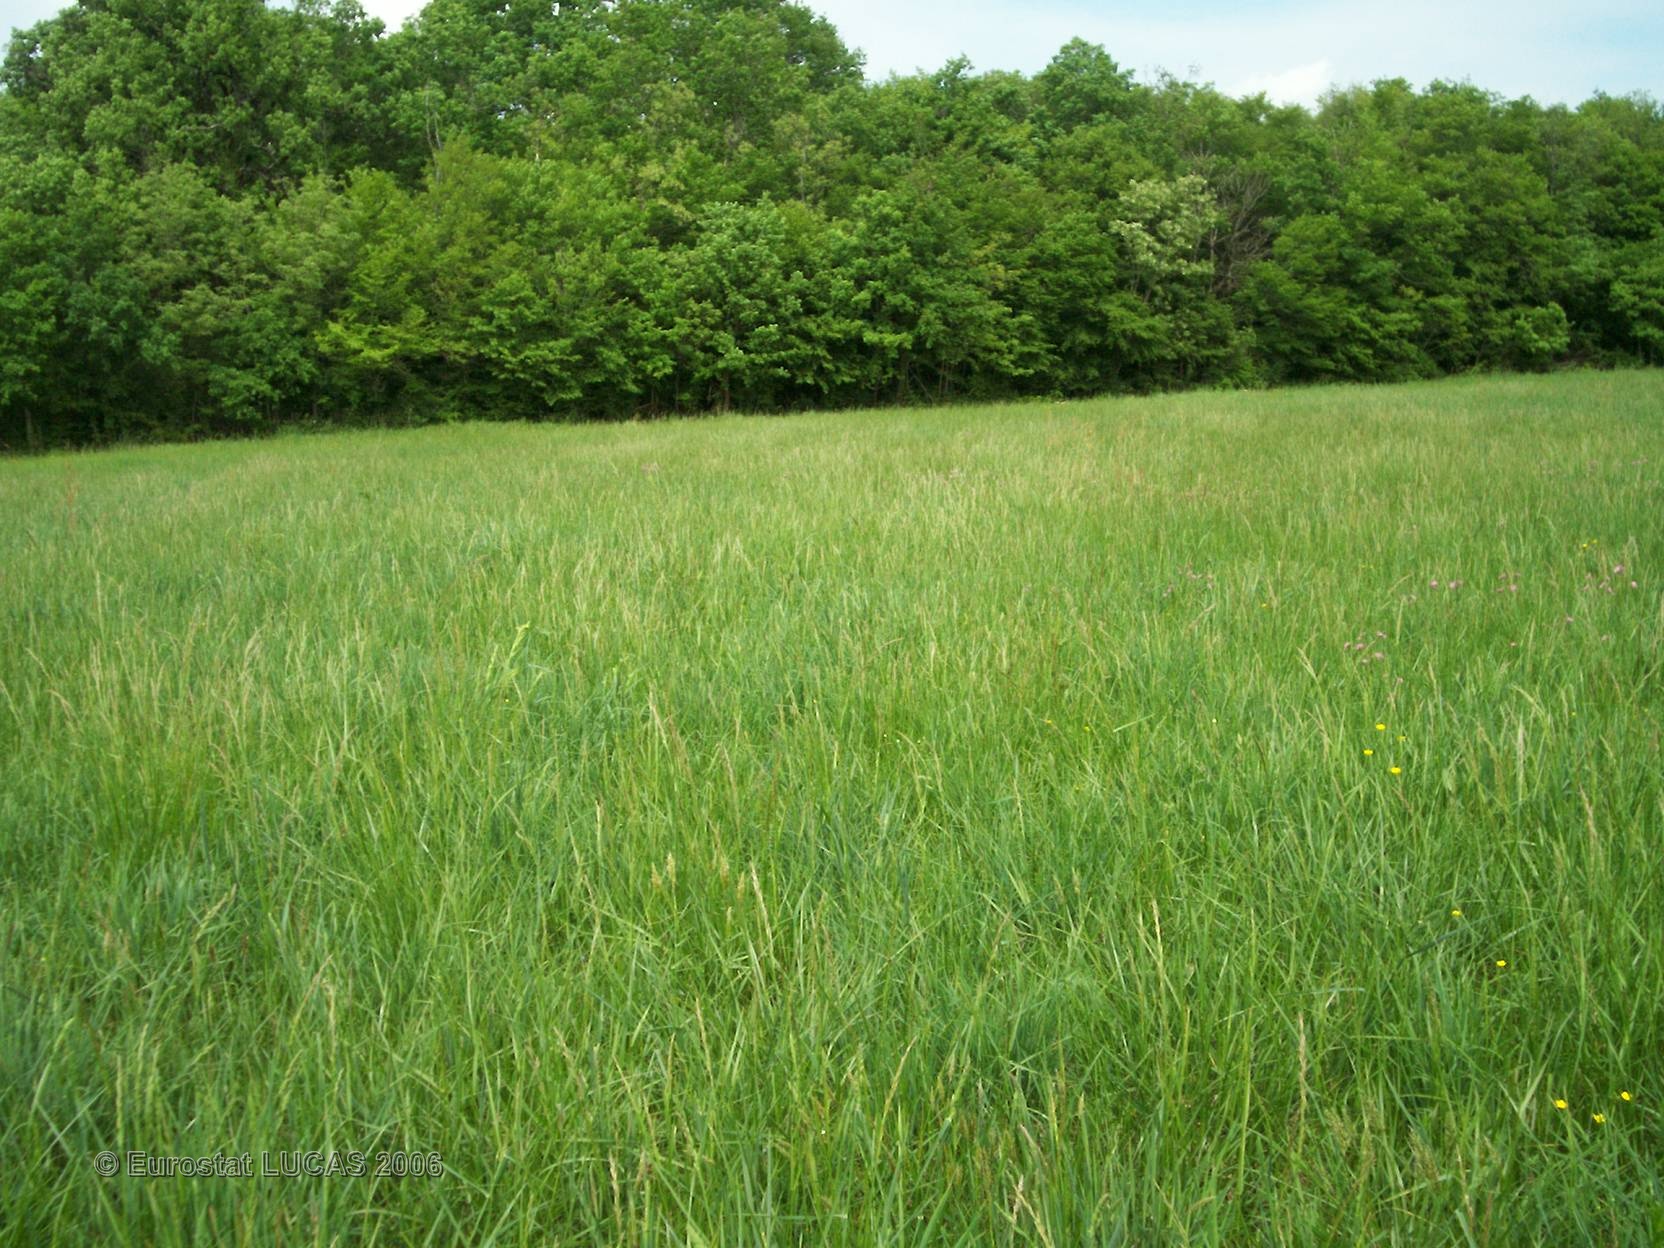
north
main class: Grassland
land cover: Grassland without tree/shrub cover
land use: Agriculture (excluding fallow land and kitchen gardens)
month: May
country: FR
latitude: 46.7338
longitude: 1.0214
